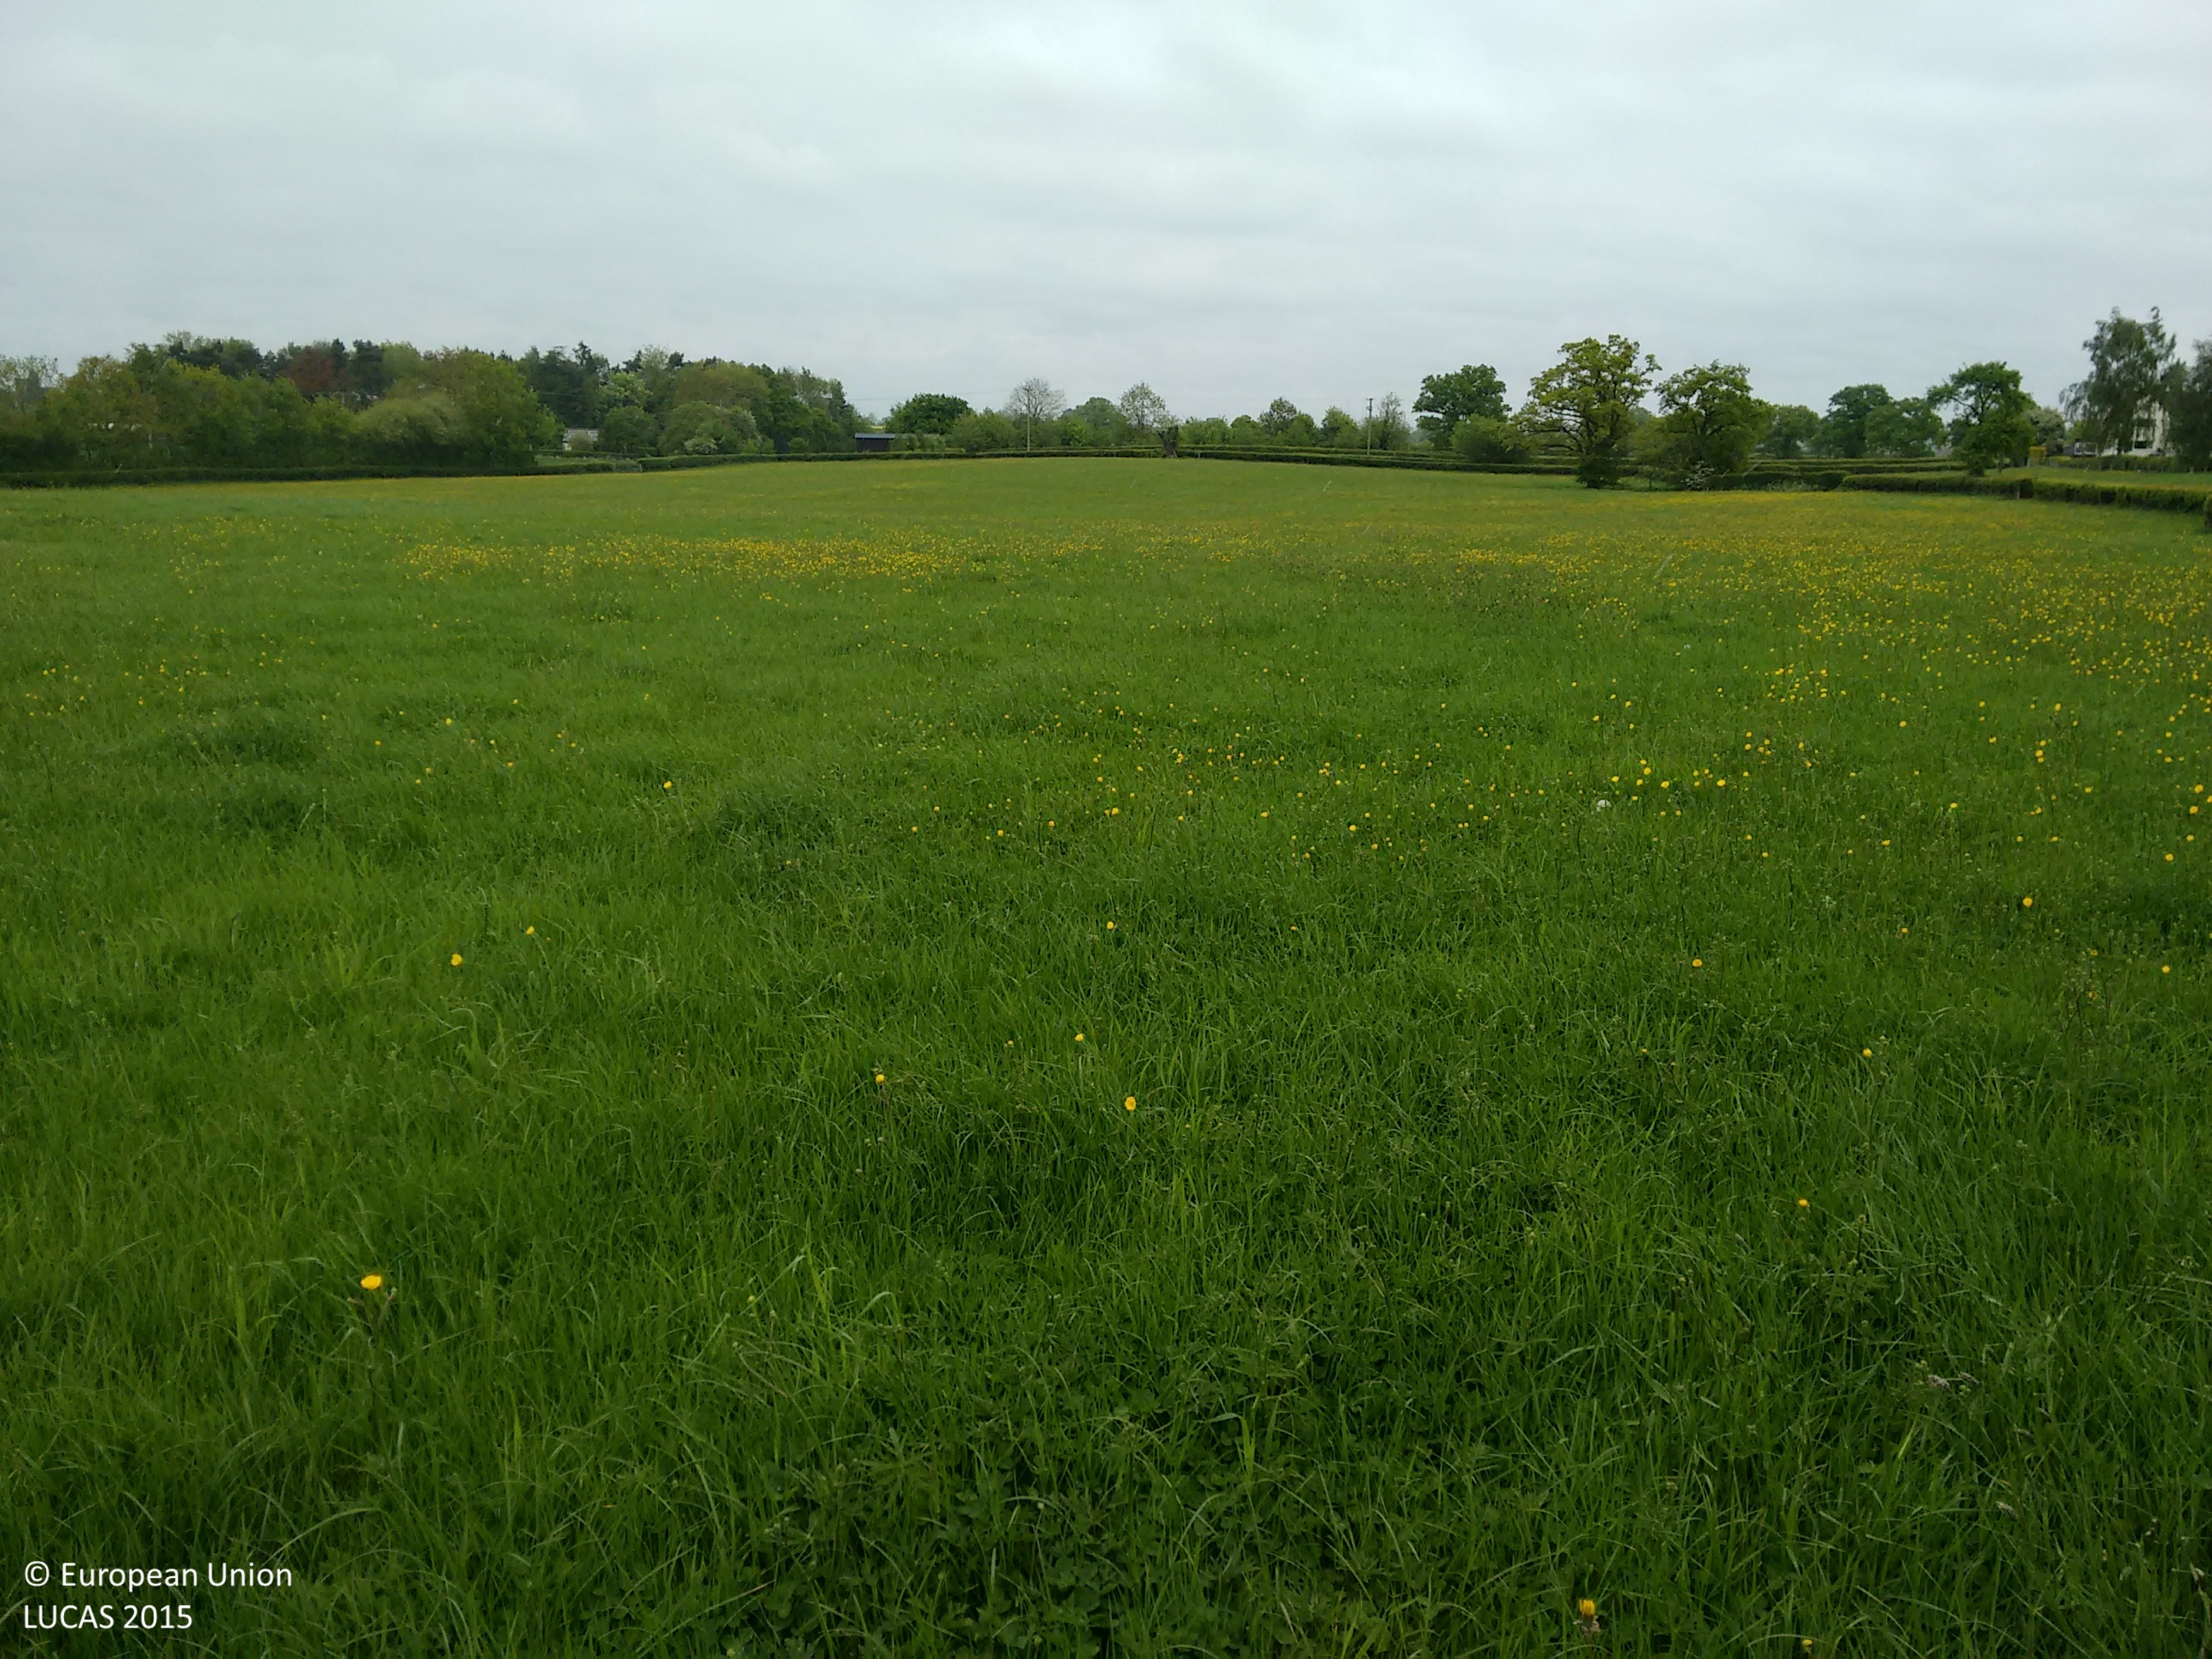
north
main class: Grassland
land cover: Grassland without tree/shrub cover
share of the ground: > 75 %
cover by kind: herbaceous plants 100 %
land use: Agriculture (excluding fallow land and kitchen gardens)
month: May
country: GB
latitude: 52.3308
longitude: -2.1674
